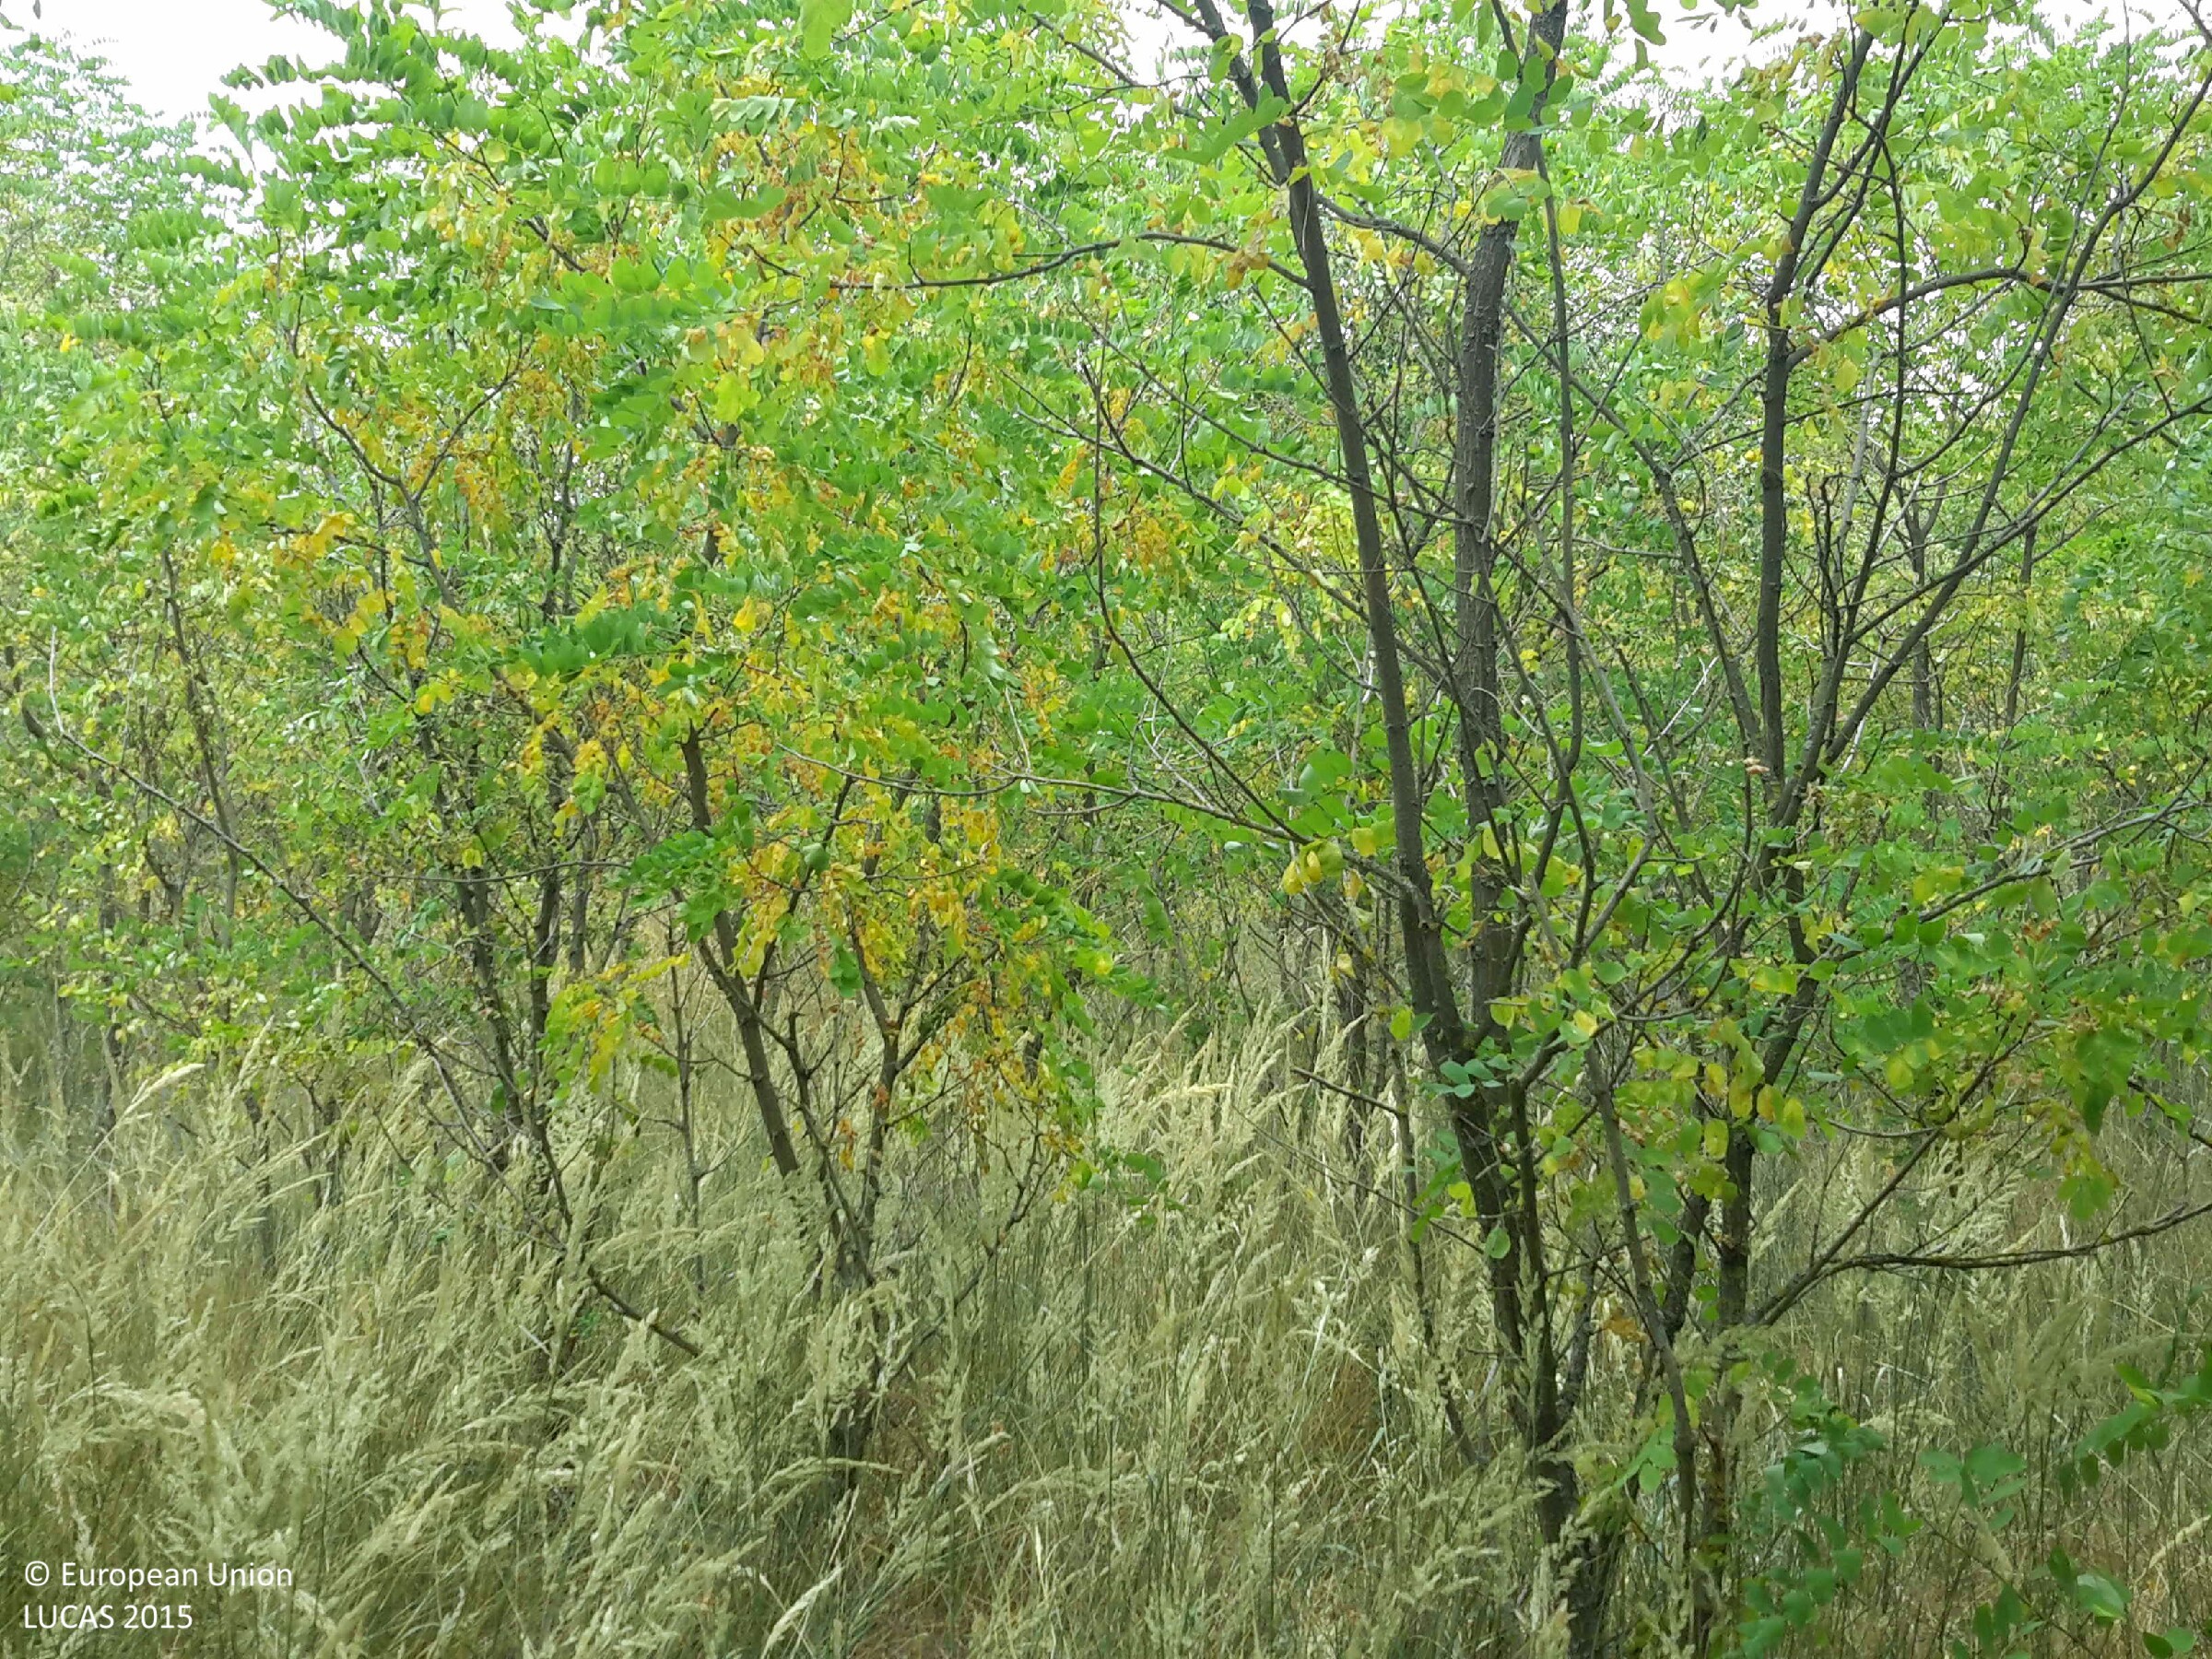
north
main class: Woodland
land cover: Broadleaved woodland
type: mesophytic deciduous forest
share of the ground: 50 - 75 %
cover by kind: broadleaved forest trees 70 %, herbaceous plants 30 %
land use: Forestry
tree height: > 5 m
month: July
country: HU
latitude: 47.4079
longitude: 17.2289
